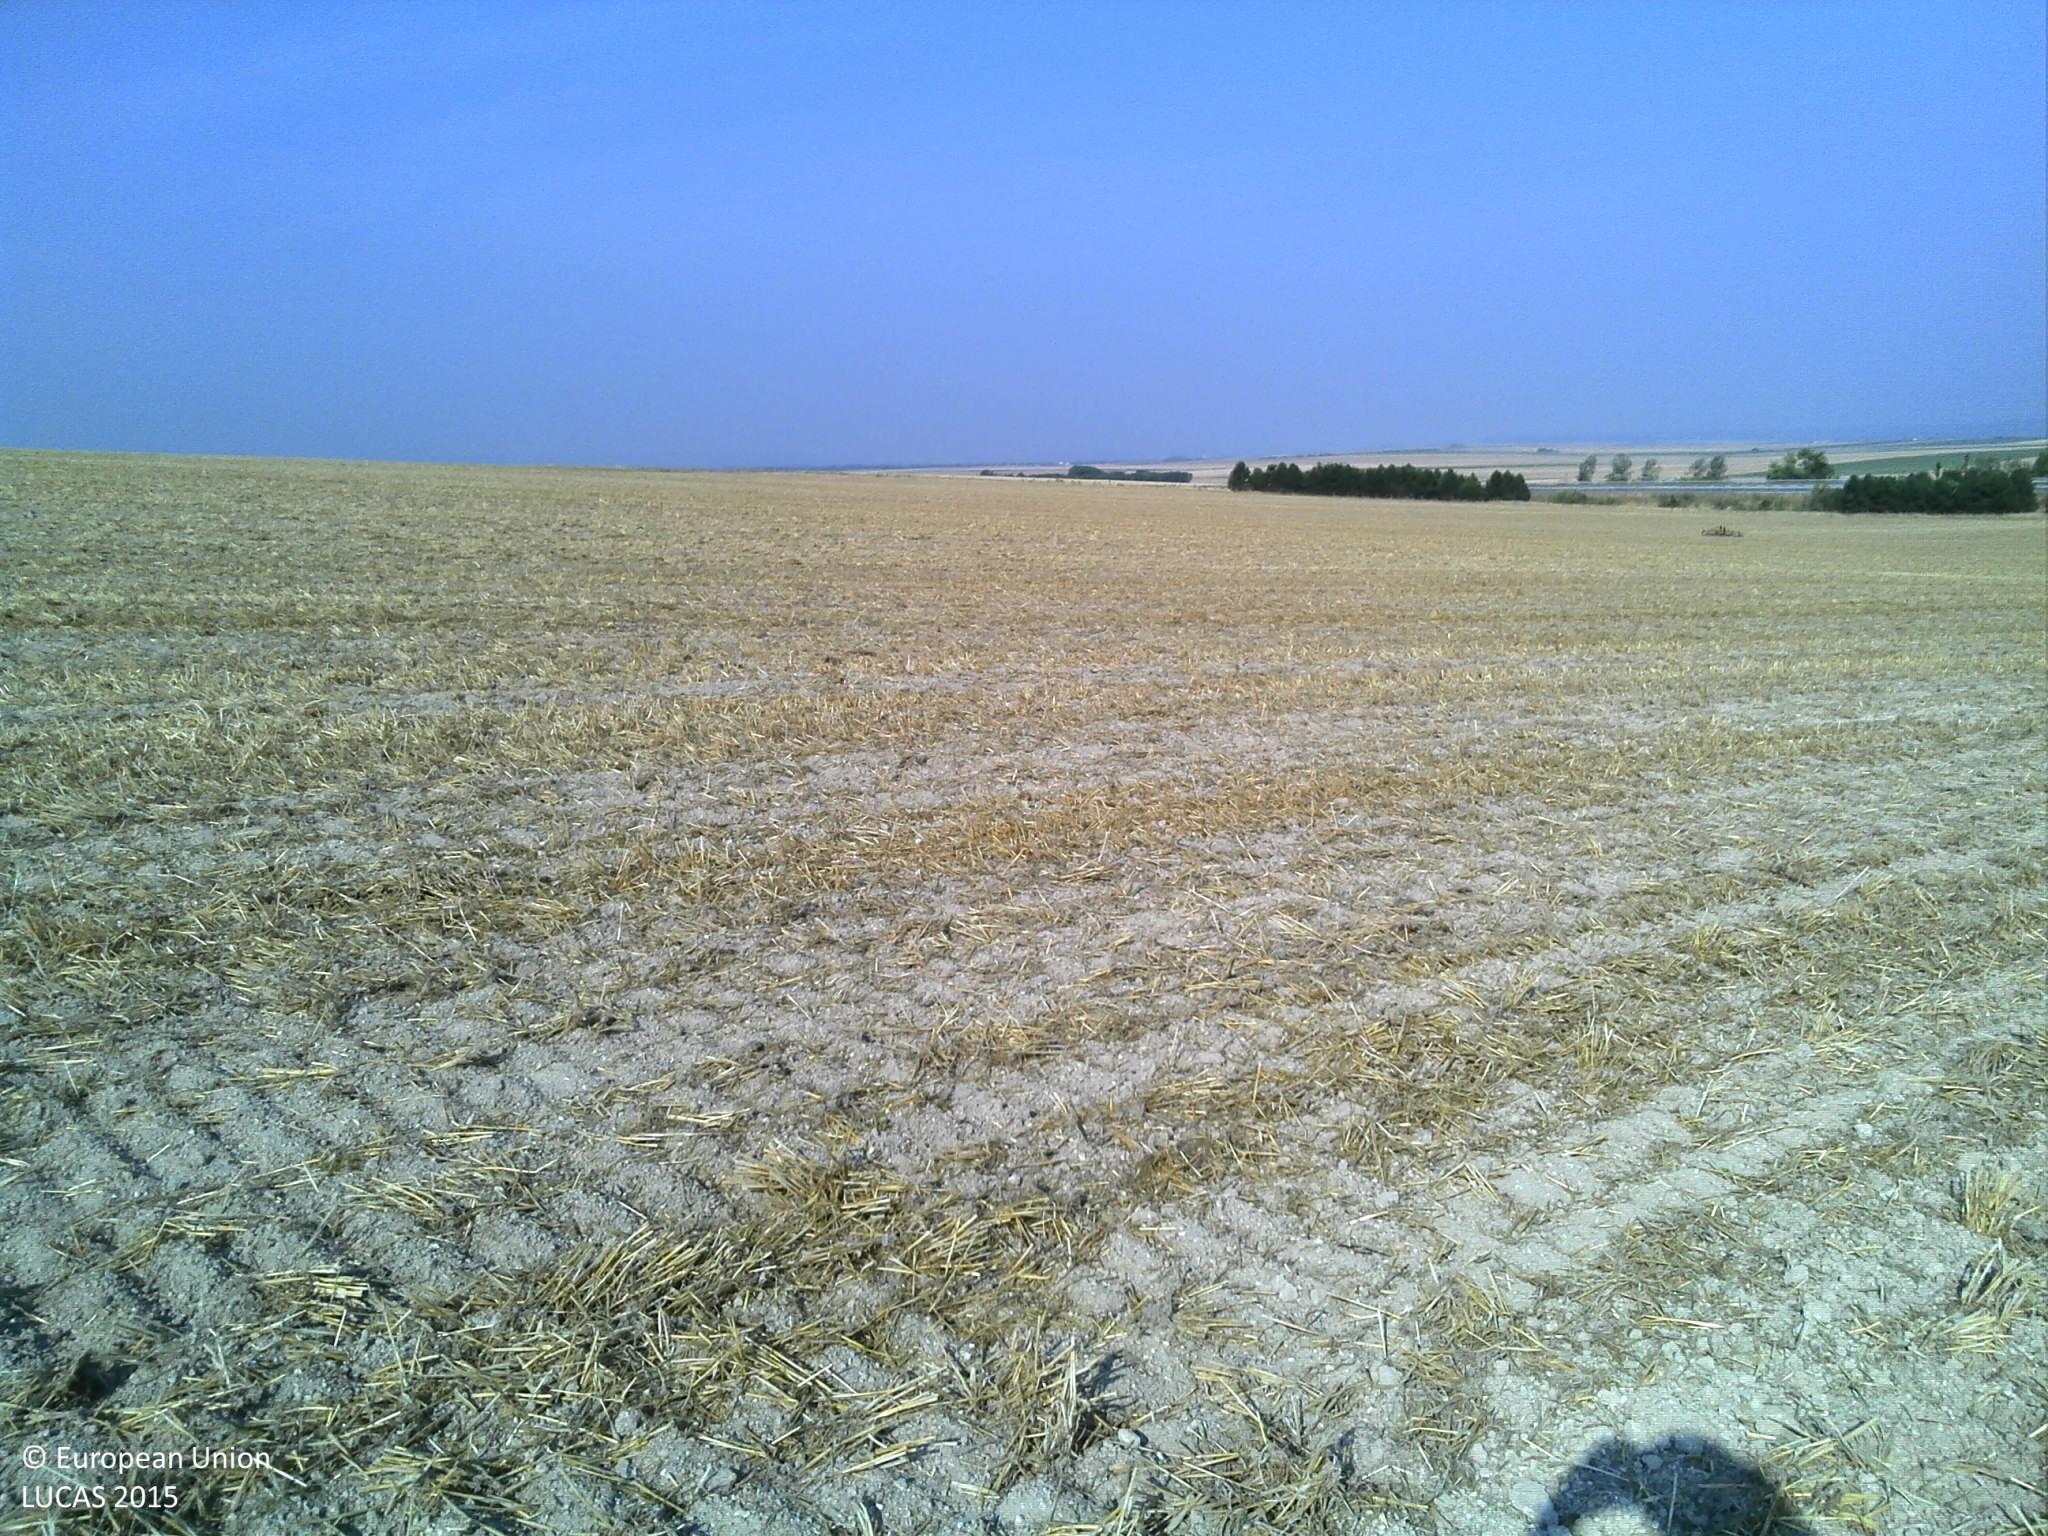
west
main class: Cropland
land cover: Common wheat
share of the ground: > 75 %
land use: Agriculture (excluding fallow land and kitchen gardens)
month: August
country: FR
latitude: 49.0495
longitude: 4.2904
